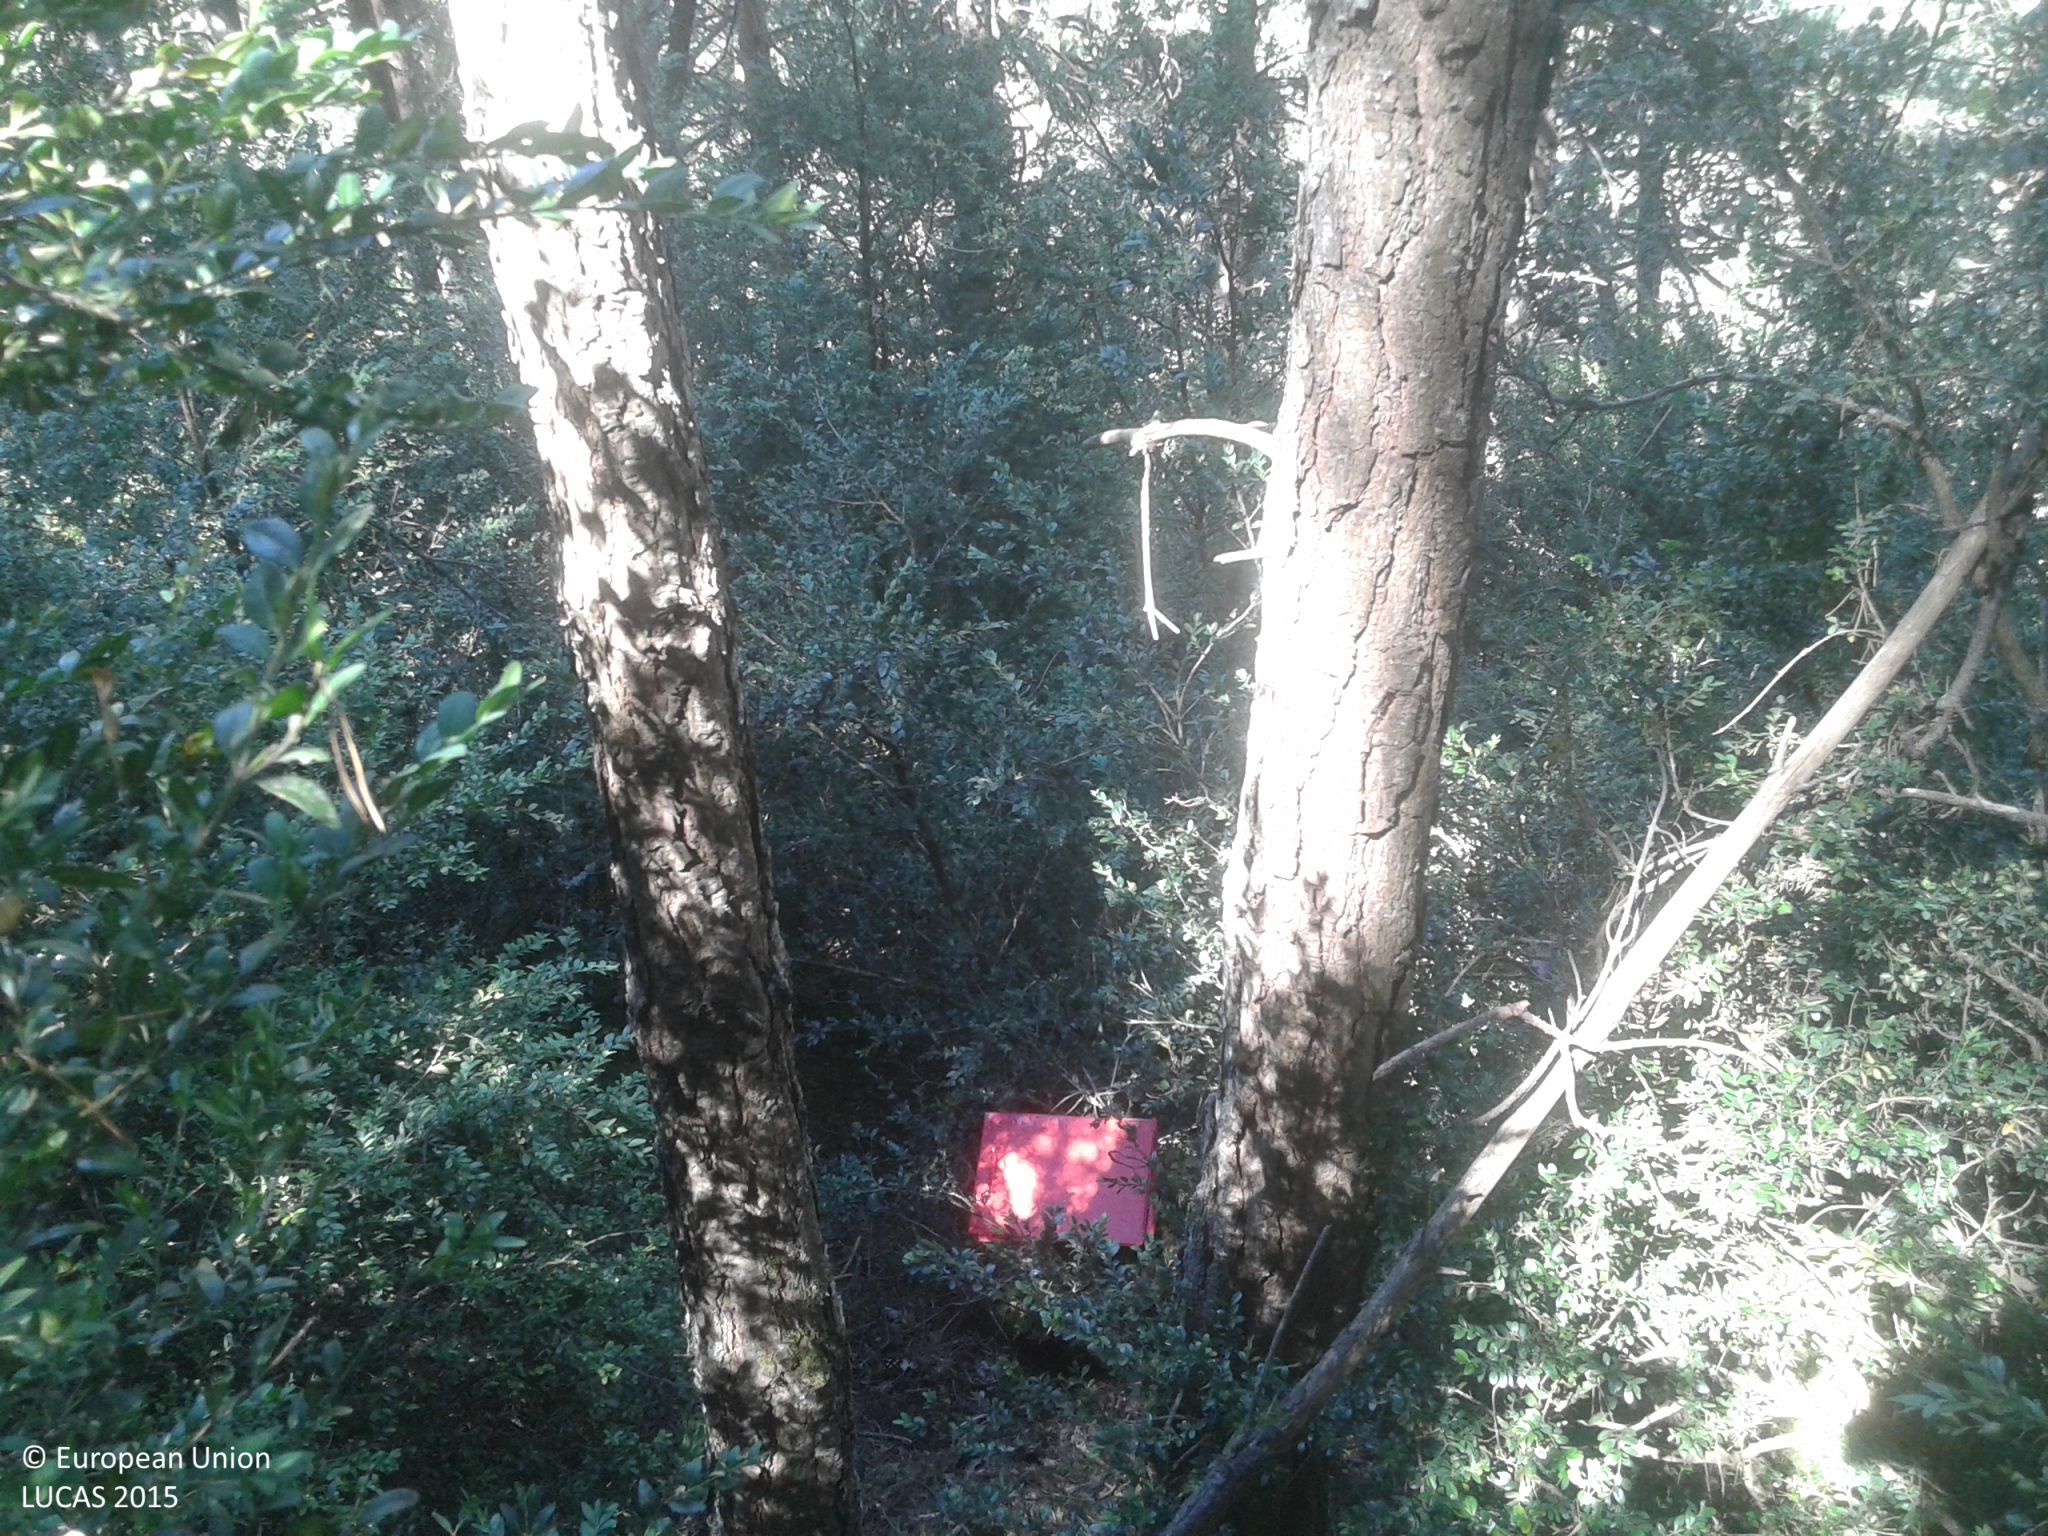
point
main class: Woodland
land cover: Pine dominated coniferous woodland
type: alpine coniferous forest
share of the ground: 50 - 75 %
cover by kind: coniferous forest trees 70 %, shrubs 30 %
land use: Semi-natural and natural areas not in use
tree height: > 5 m
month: July
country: ES
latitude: 42.3168
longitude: 1.5294
